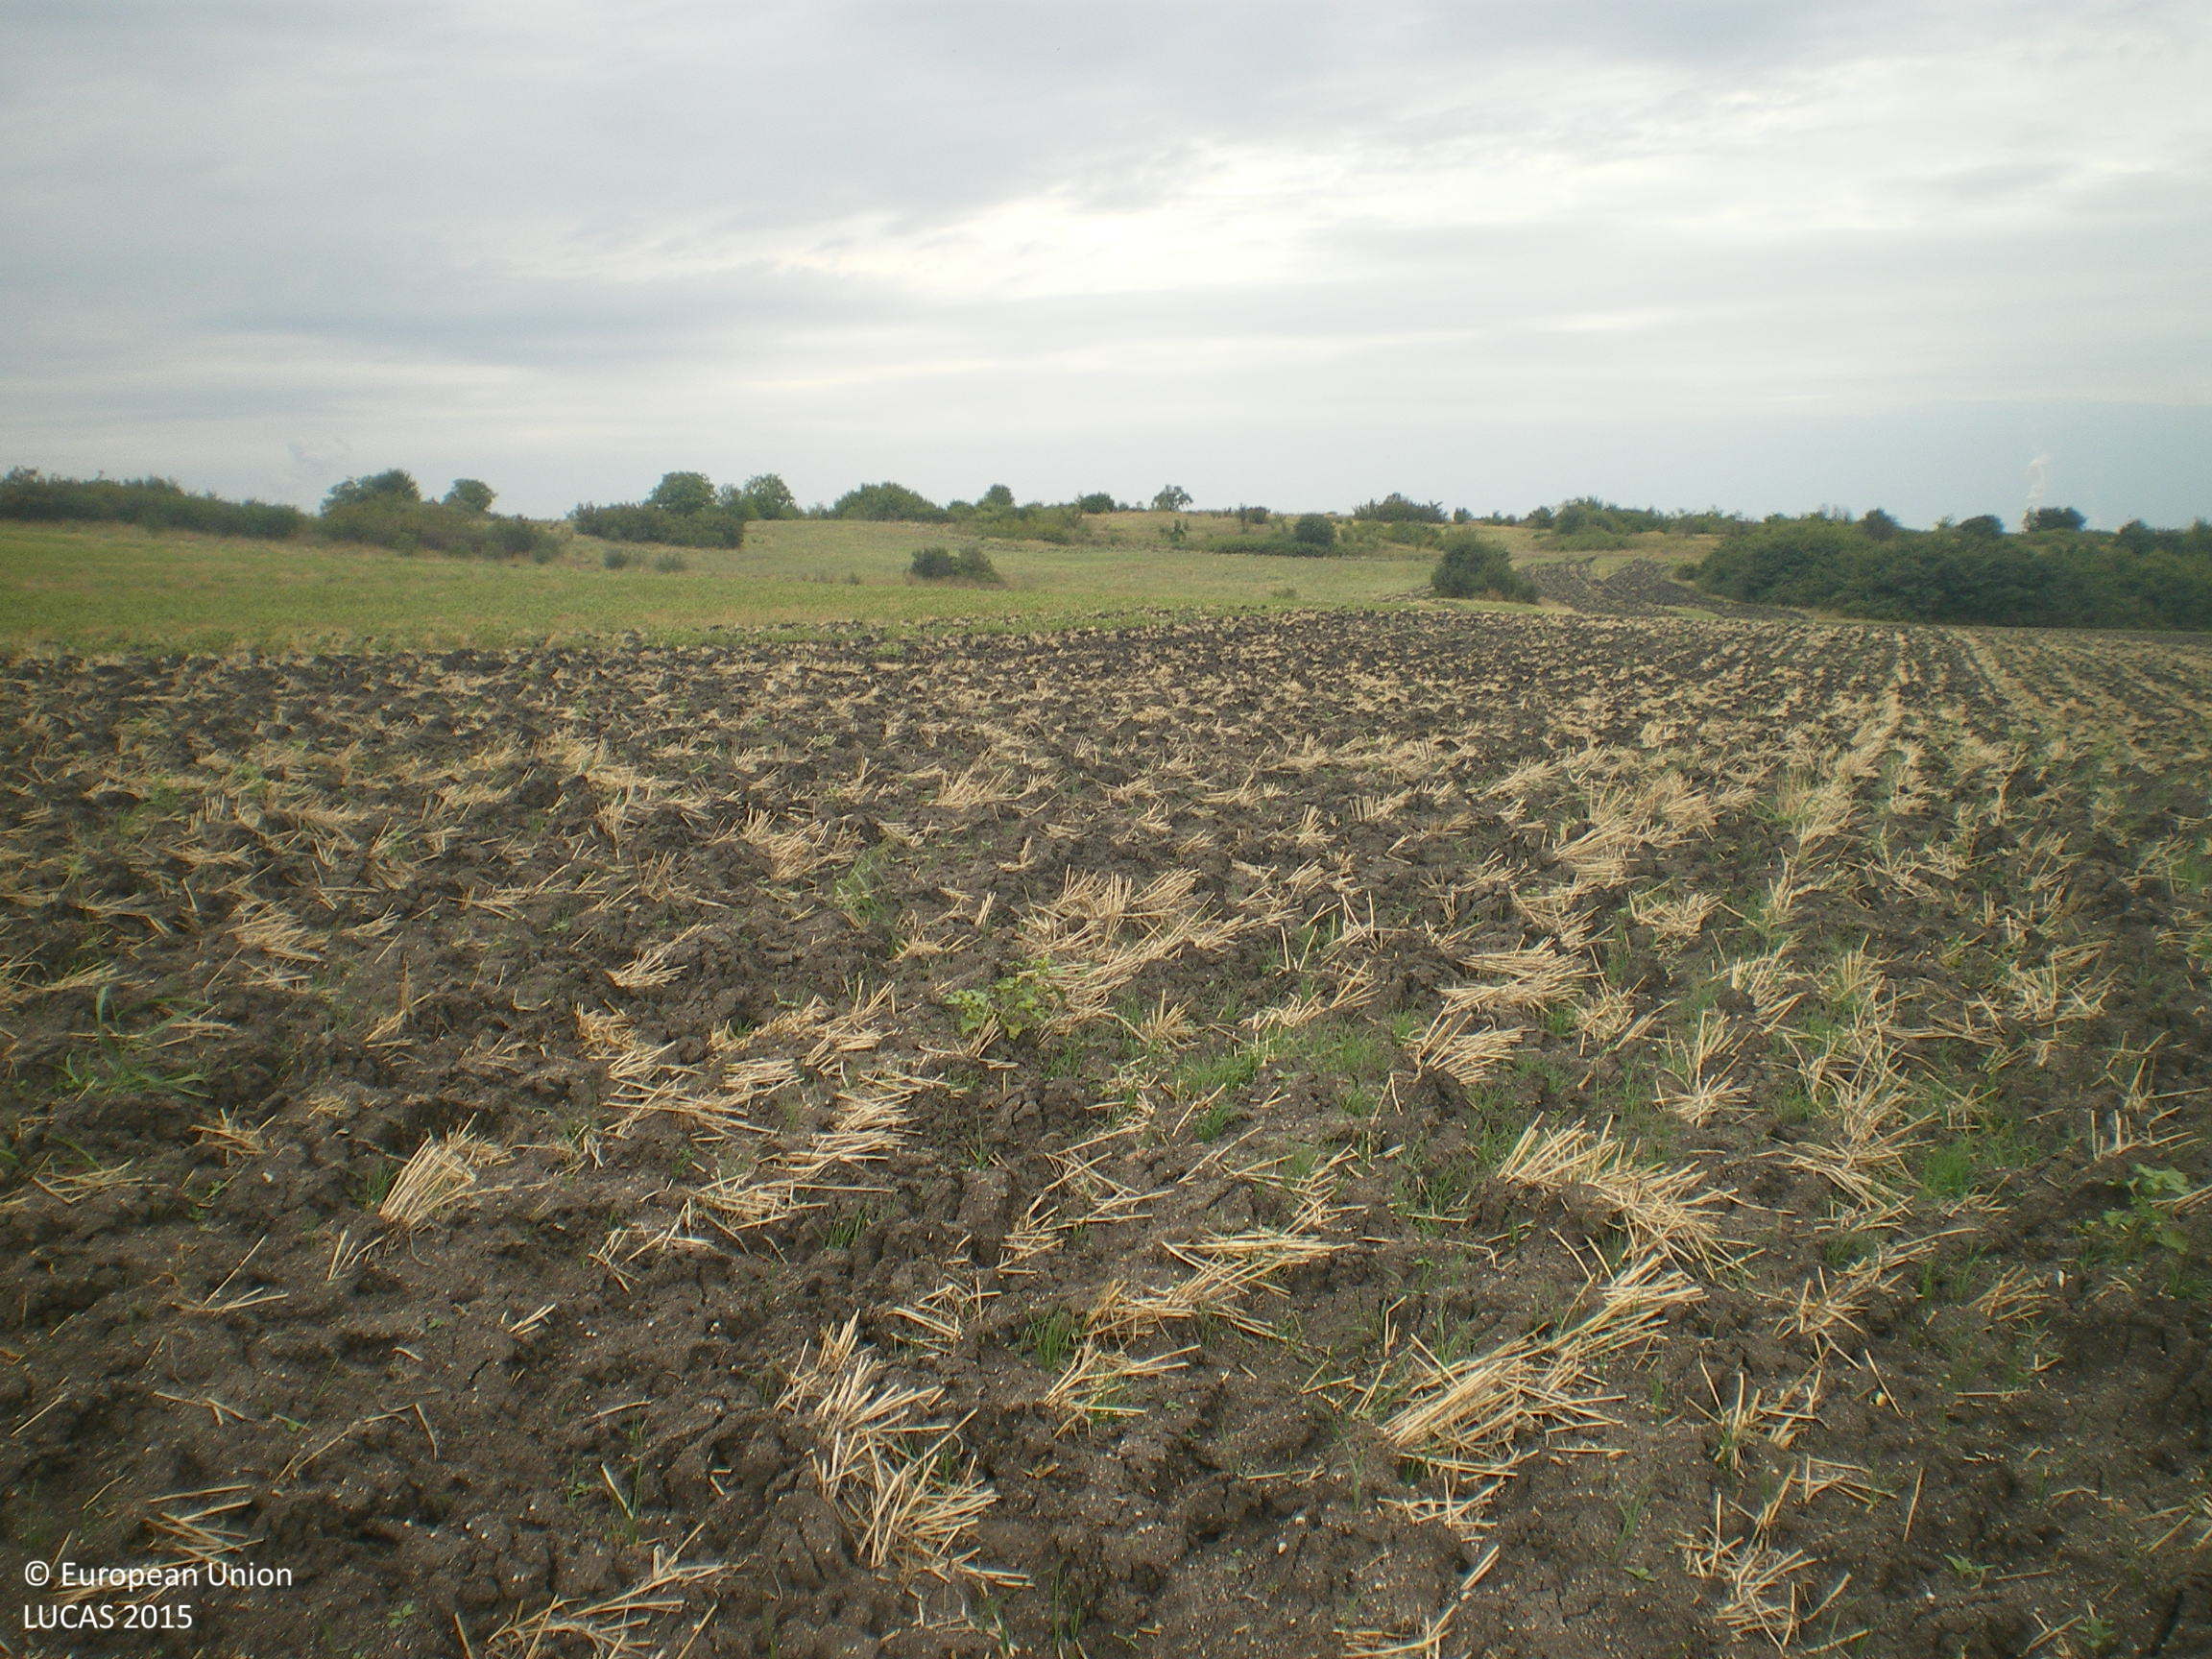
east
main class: Cropland
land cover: Common wheat
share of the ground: < 10 %
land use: Agriculture (excluding fallow land and kitchen gardens)
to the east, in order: Common wheat; Grass margins; Tracks; Grassland with sparse tree/shrub cover
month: September
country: BG
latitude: 42.2041
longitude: 25.8553
